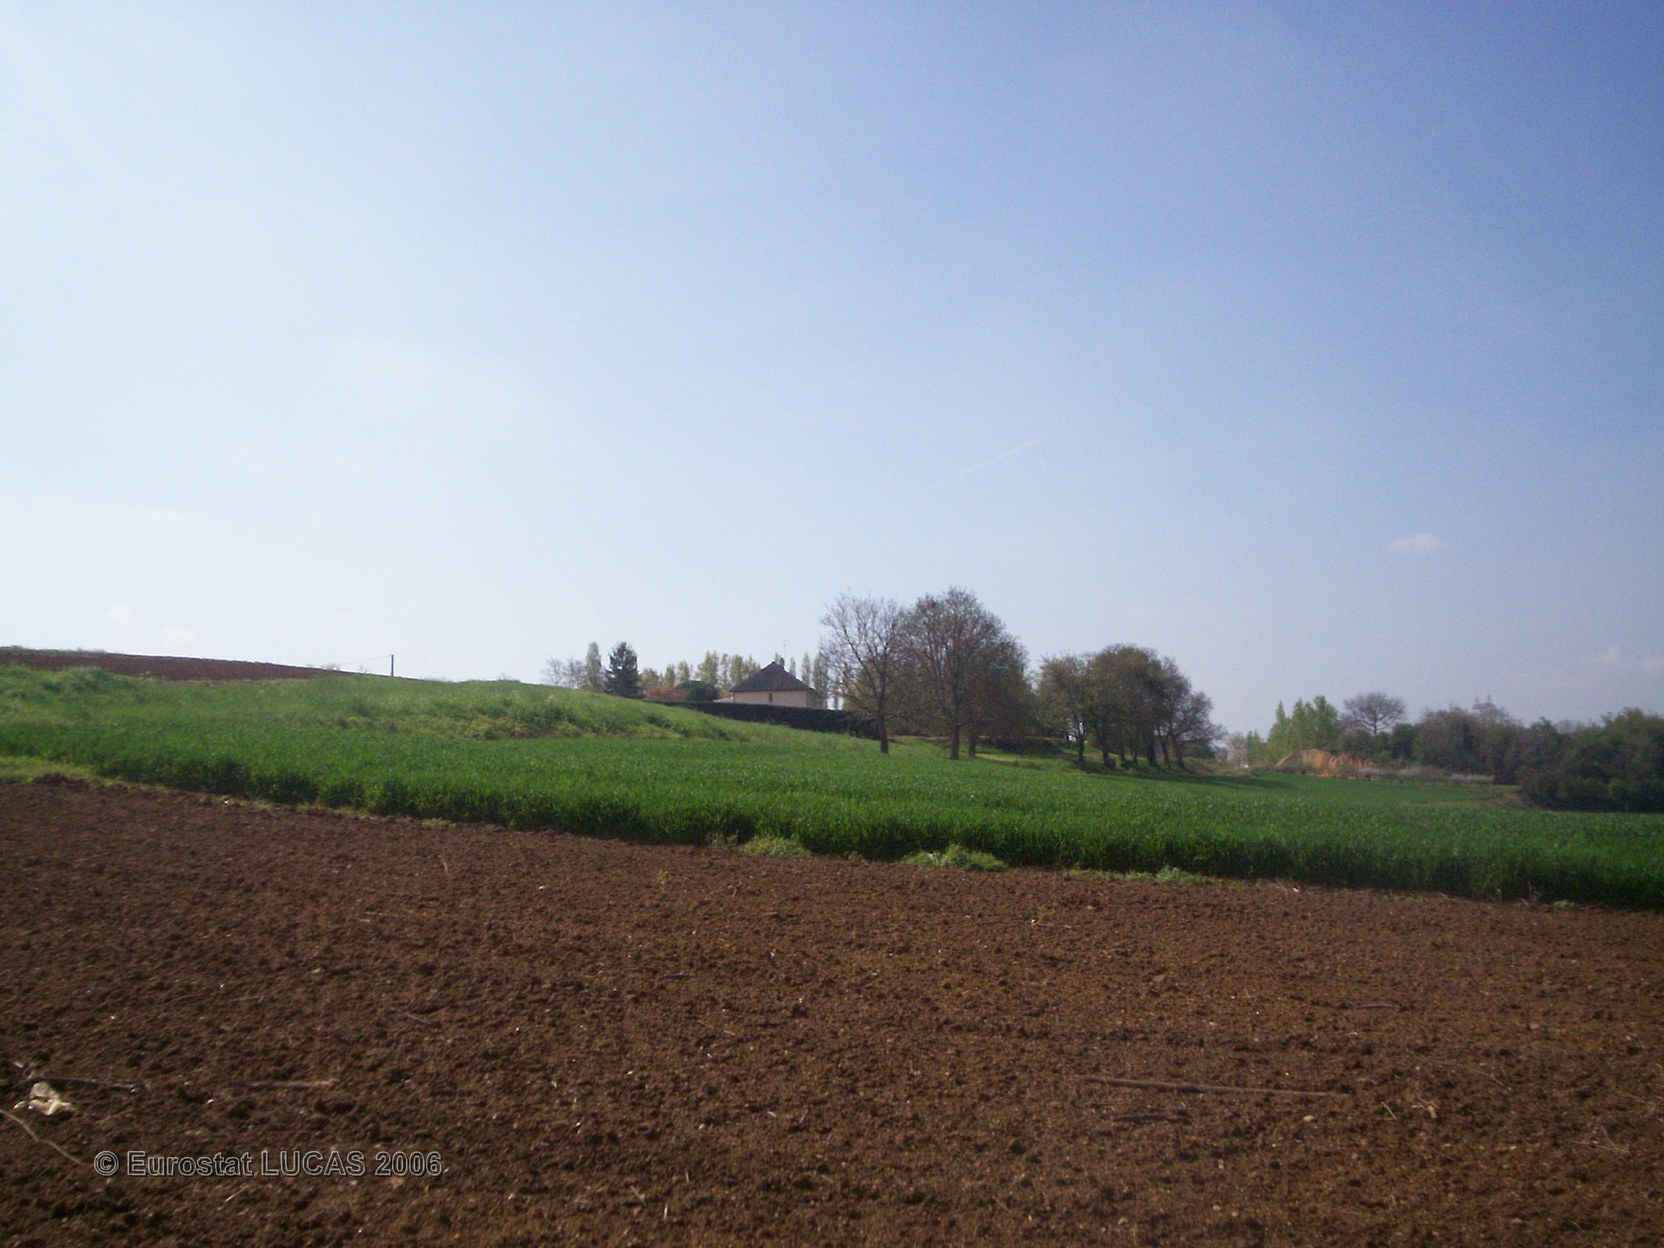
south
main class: Cropland
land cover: Sunflower
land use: Agriculture (excluding fallow land and kitchen gardens)
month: April
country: FR
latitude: 47.2430
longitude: -0.3728
